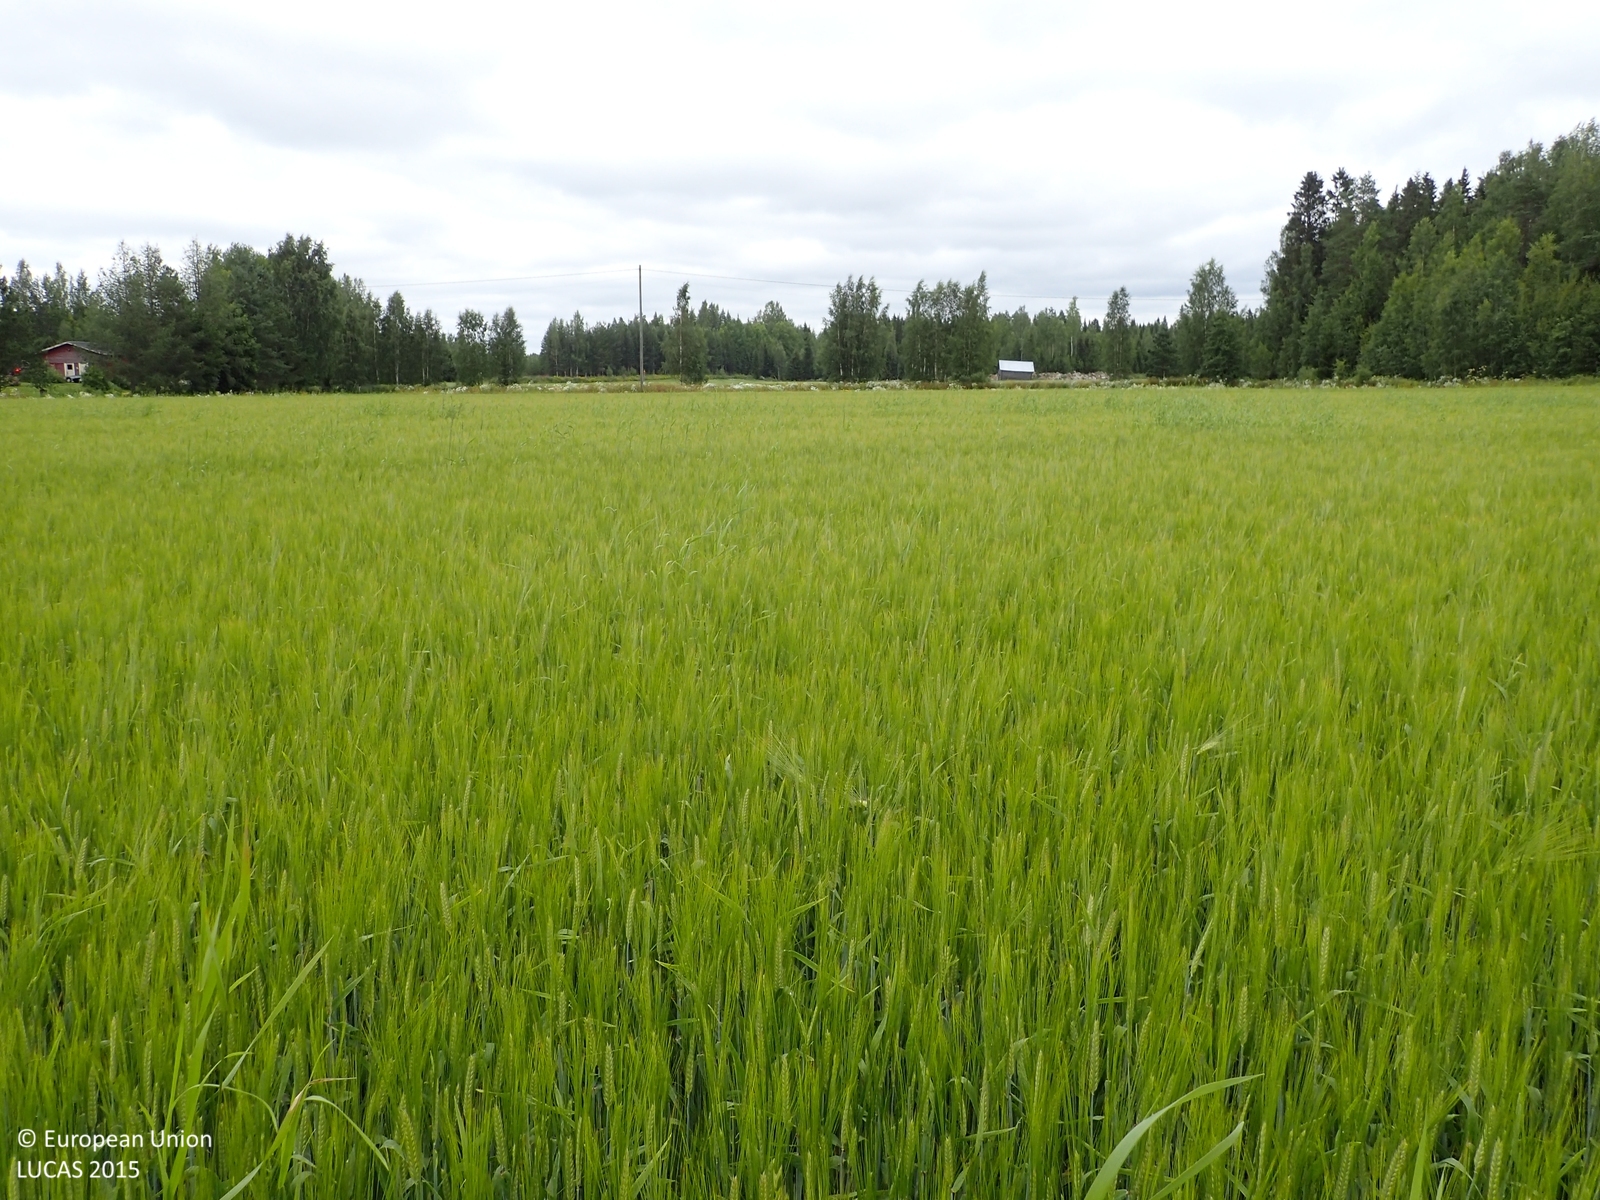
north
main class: Cropland
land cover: Barley
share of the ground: > 75 %
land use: Agriculture (excluding fallow land and kitchen gardens)
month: August
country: FI
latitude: 62.8753
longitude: 22.0591
